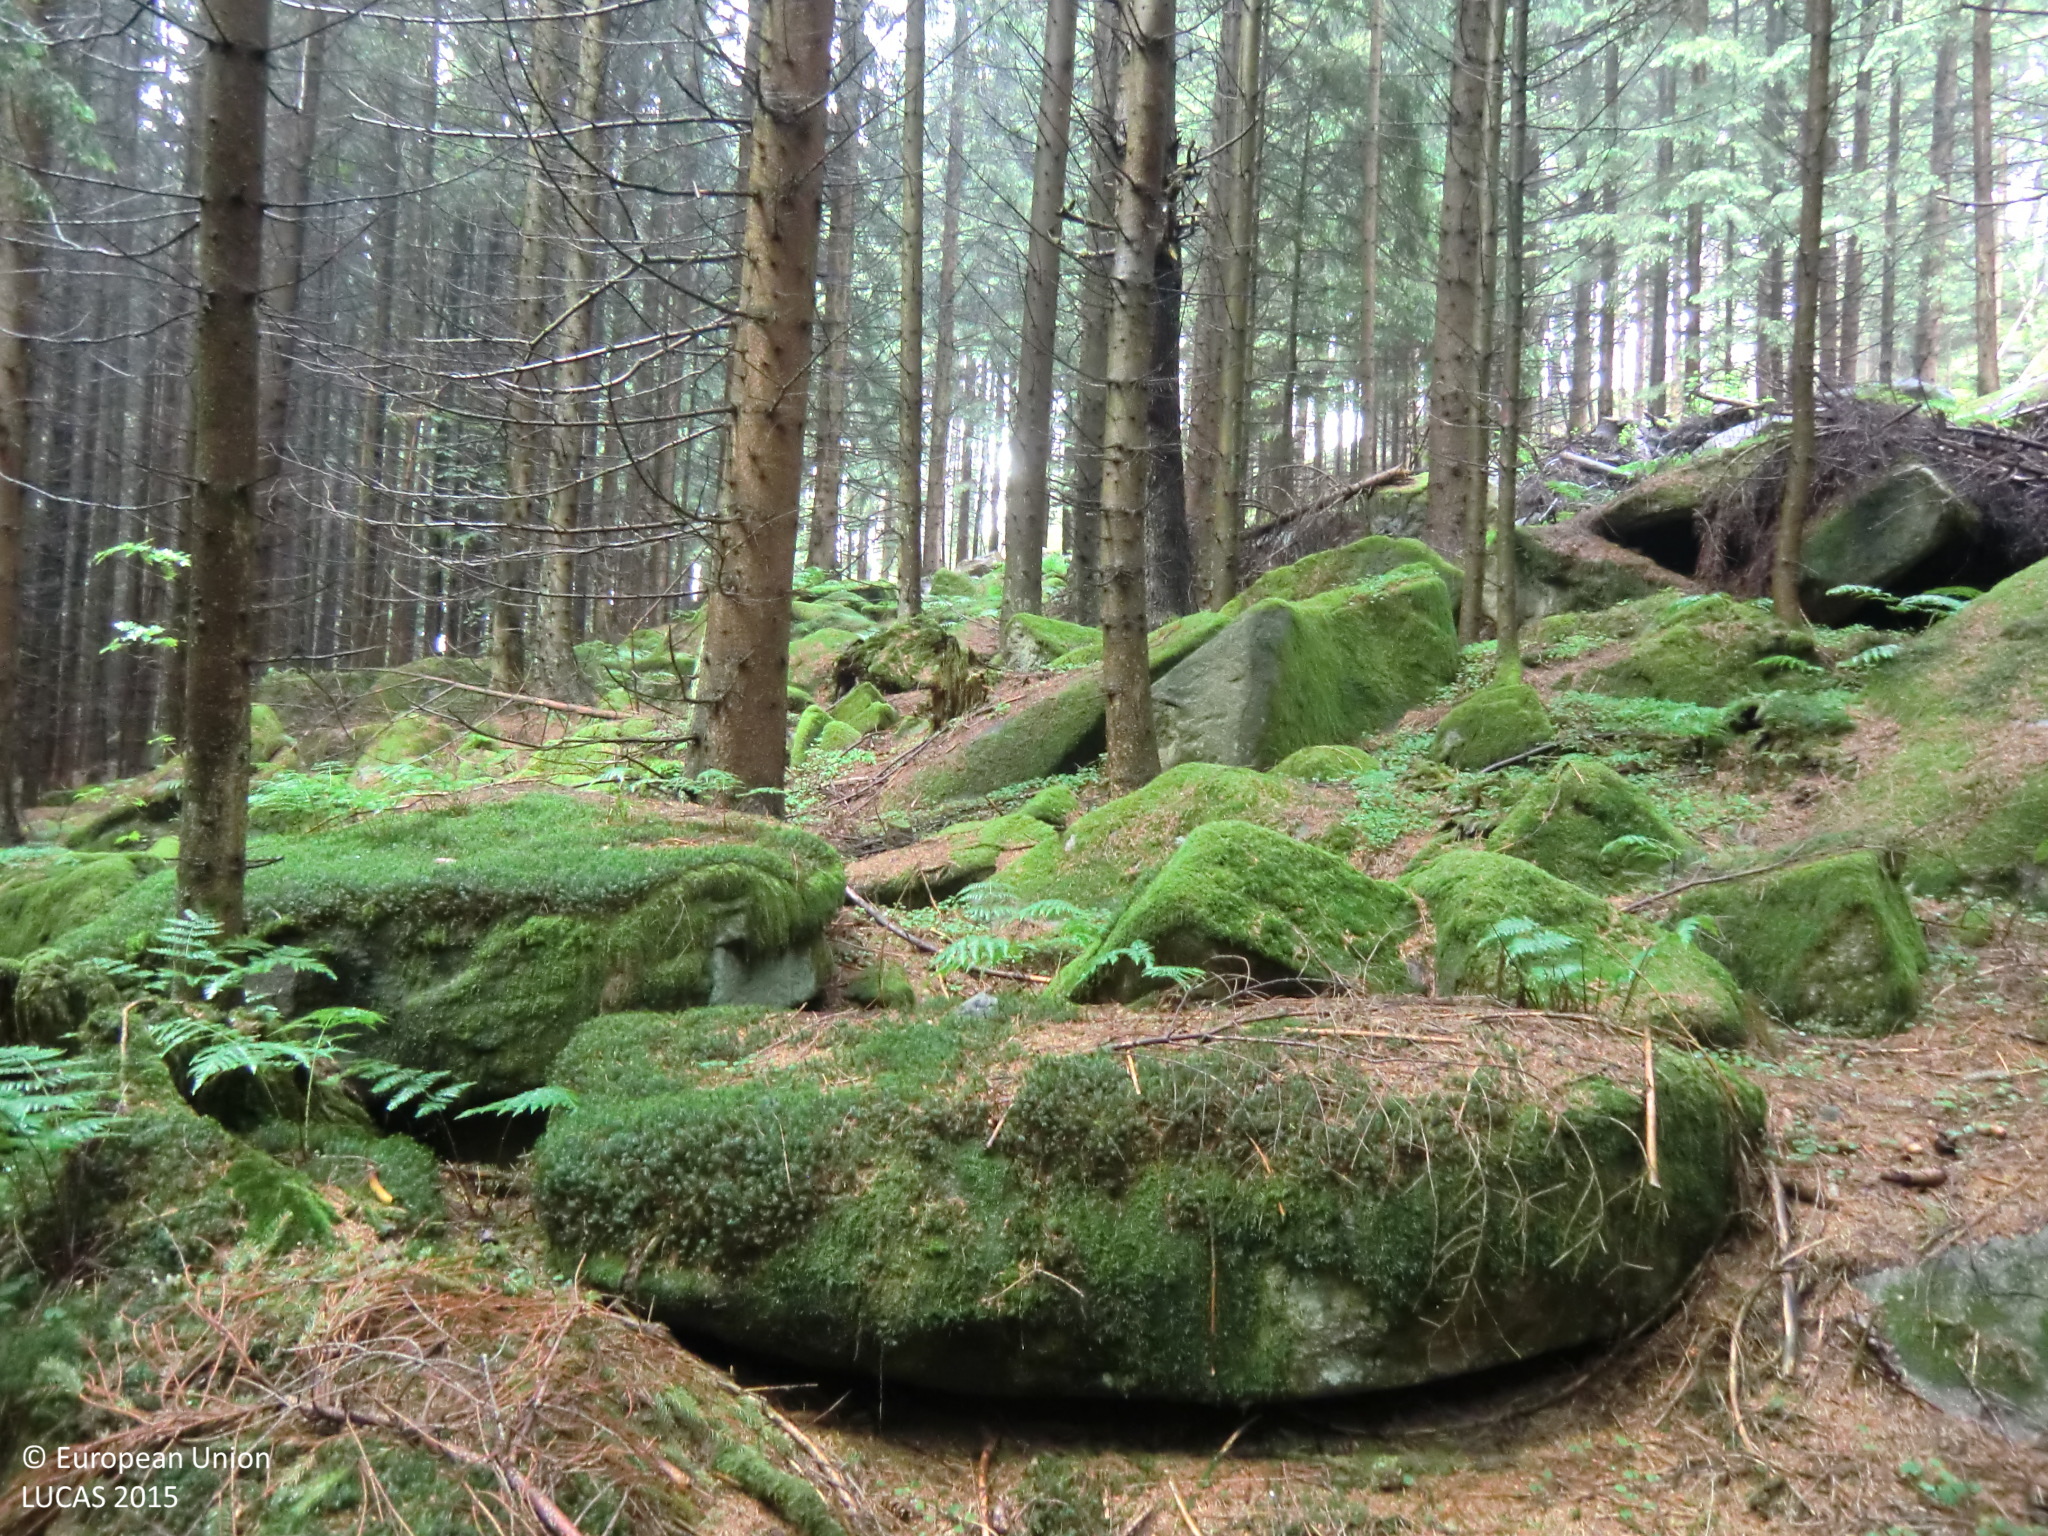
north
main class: Woodland
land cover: Spruce dominated coniferous woodland
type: hemiboreal forest and nemoral coniferous forest and mixed broadleaved-coniferous forest
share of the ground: > 75 %
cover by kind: coniferous forest trees 75 %, unconsolidated bare surface 15 %, herbaceous plants 10 %
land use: Forestry
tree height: > 5 m
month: June
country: AT
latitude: 48.5244
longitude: 14.5910
